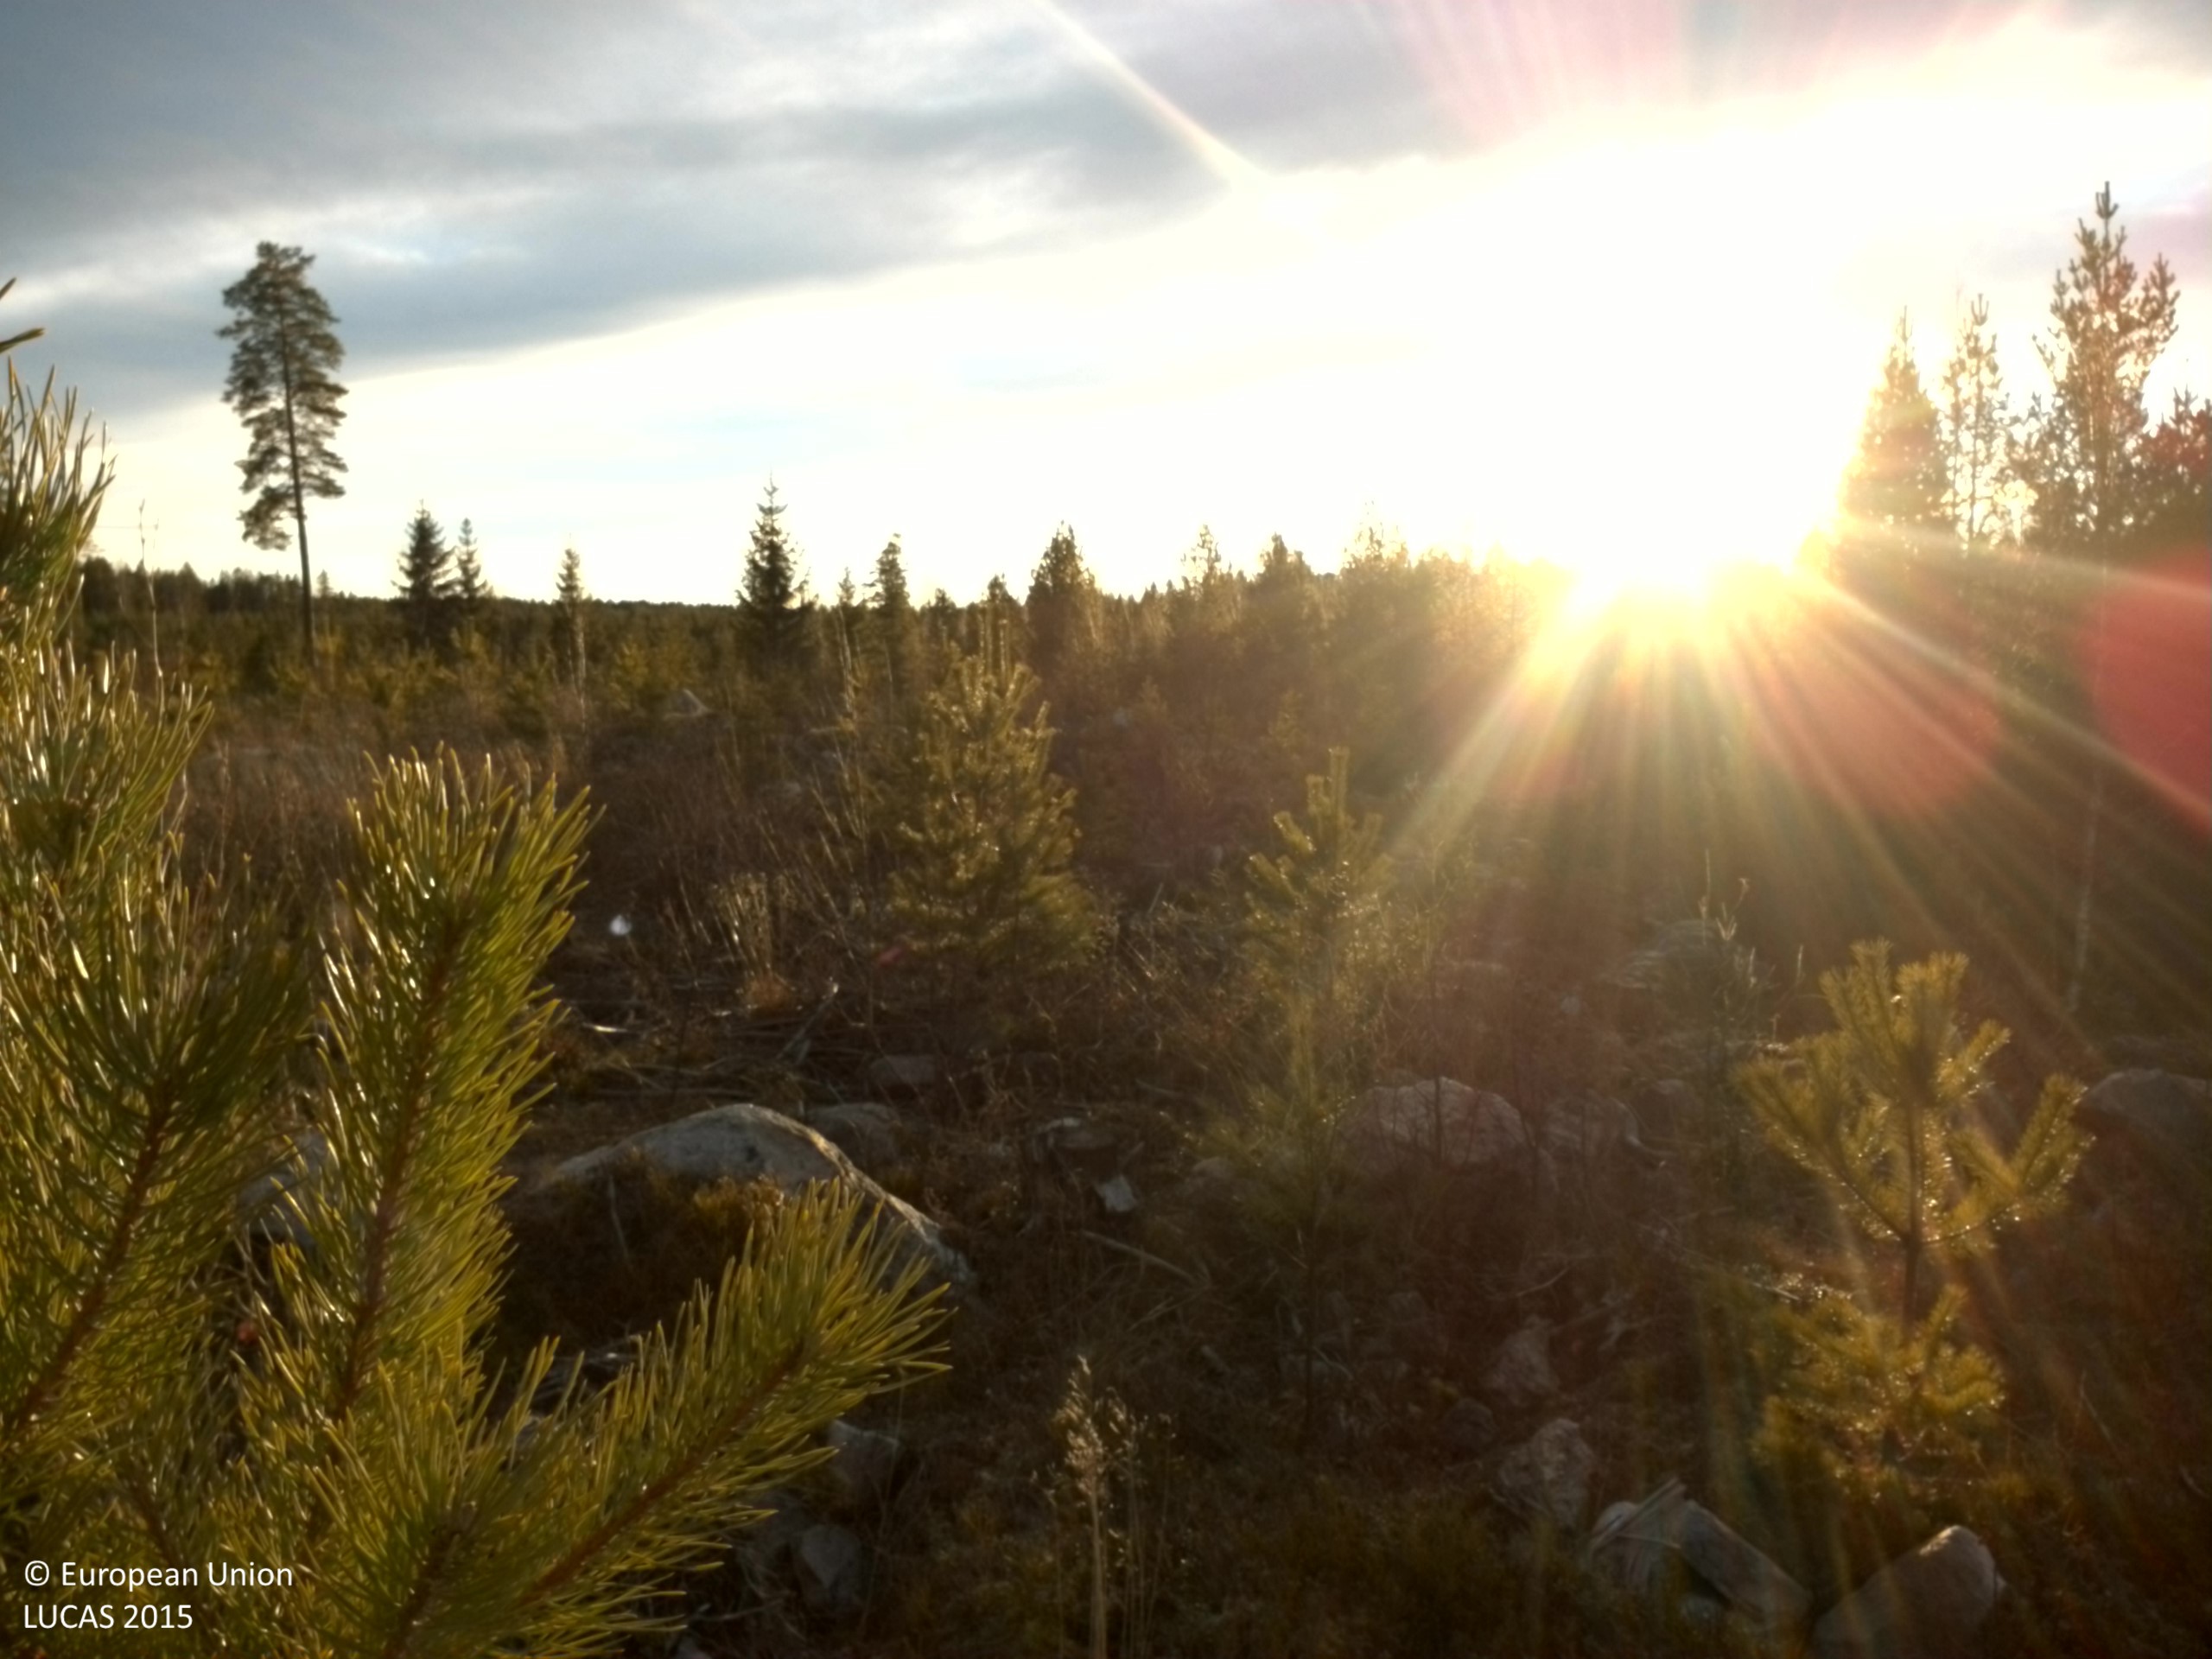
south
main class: Woodland
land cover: Pine dominated mixed woodland
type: boreal forest
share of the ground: 10 - 25 %
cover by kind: shrubs 35 %, herbaceous plants 20 %, coniferous forest trees 15 %, consolidated bare surface 15 %, lichens and mosses 10 %, broadleaved forest trees 5 %
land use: Forestry
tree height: < 5 m
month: December
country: SE
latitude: 61.0249
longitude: 16.8894
